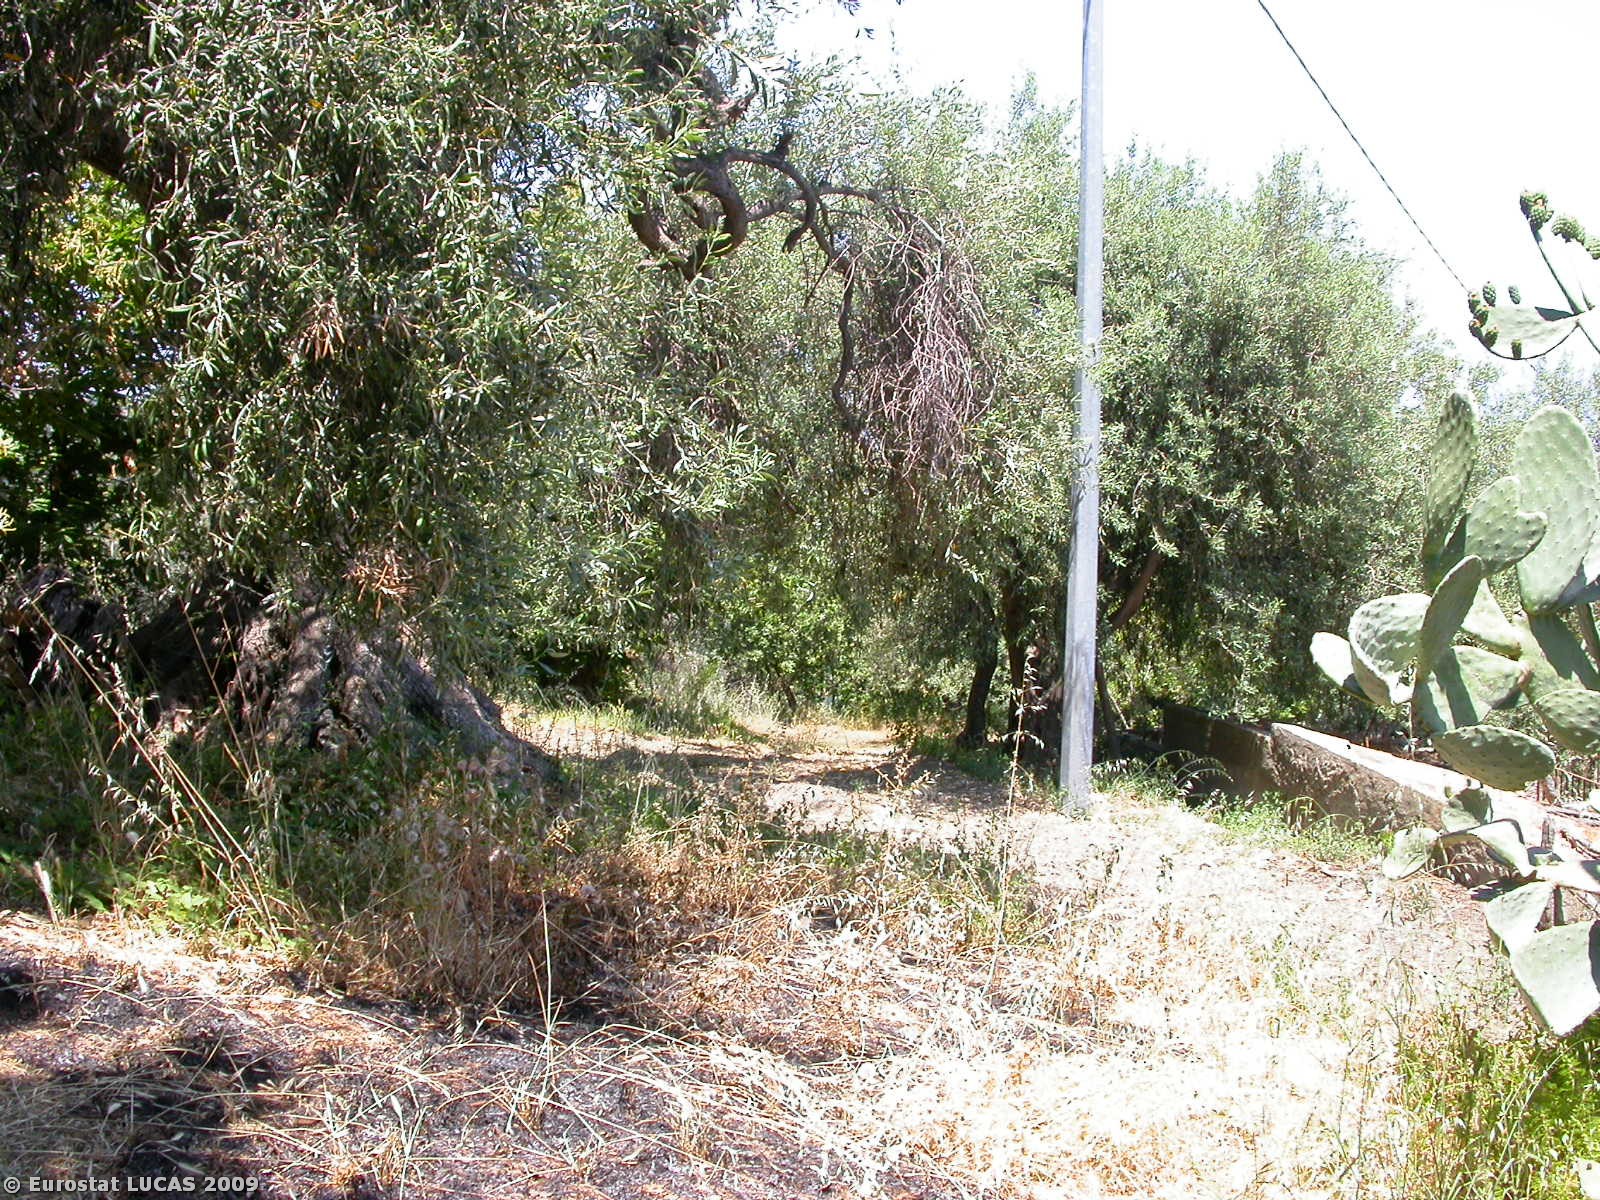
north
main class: Cropland
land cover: Olive groves
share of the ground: 50 - 75 %
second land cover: Spontaneously vegetated surfaces
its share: 50 - 75 %
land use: Agriculture (excluding fallow land and kitchen gardens)
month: June
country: IT
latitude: 38.1274
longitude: 14.9527
